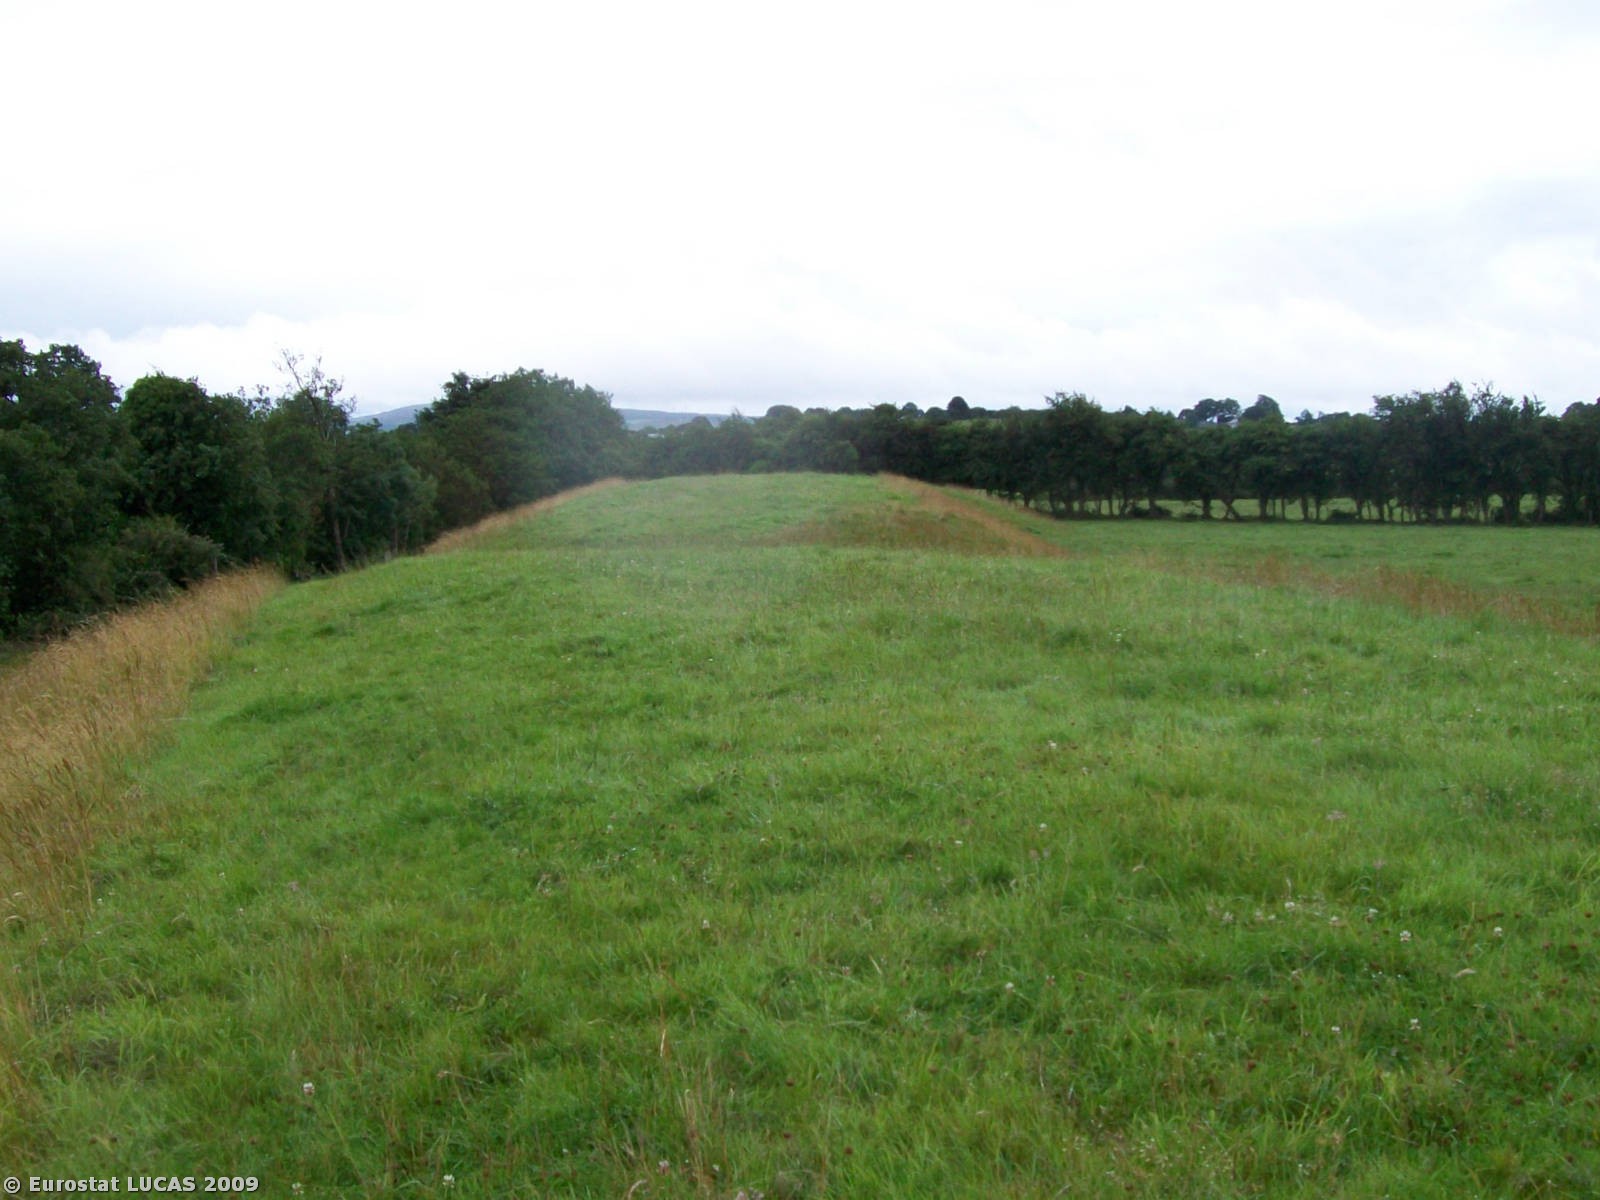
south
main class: Grassland
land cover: Grassland without tree/shrub cover
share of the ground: > 75 %
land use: Agriculture (excluding fallow land and kitchen gardens)
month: July
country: IE
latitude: 53.9361
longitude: -9.0880
